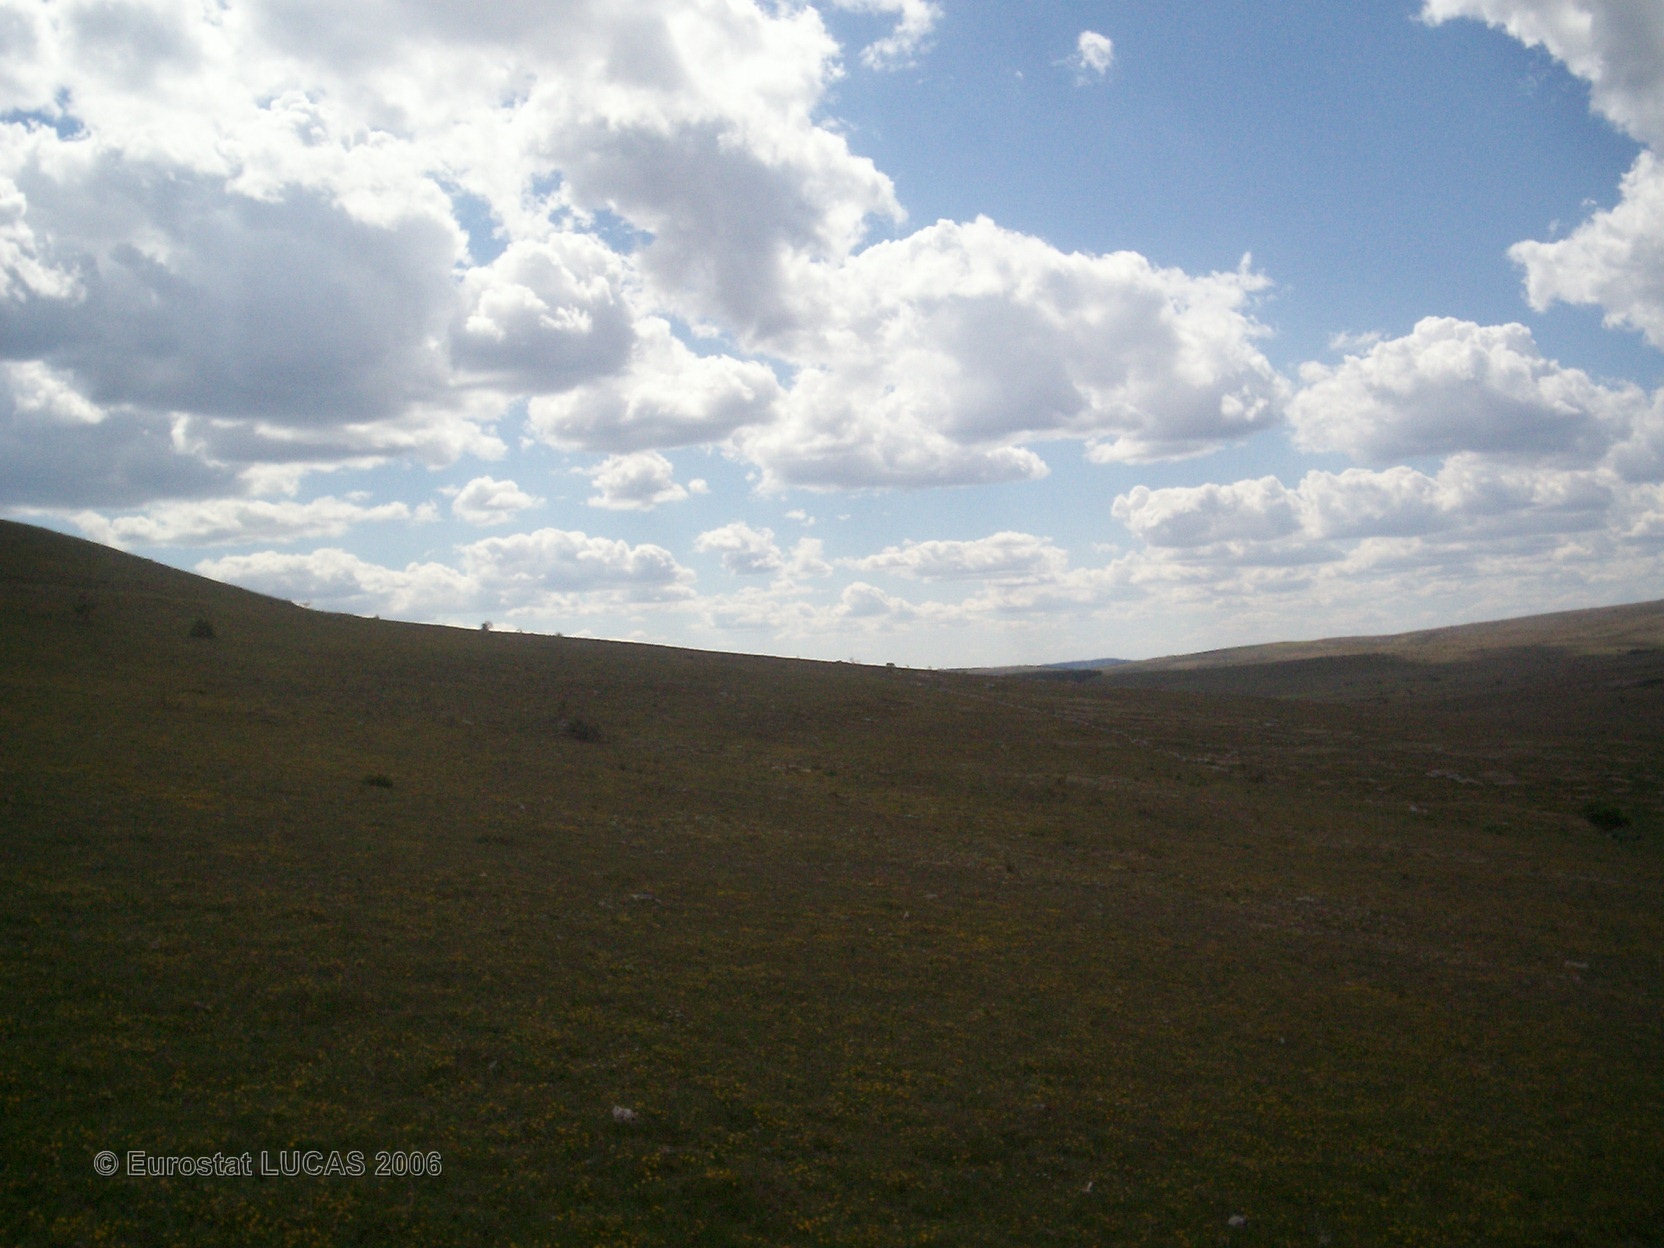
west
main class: Grassland
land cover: Grassland without tree/shrub cover
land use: Agriculture (excluding fallow land and kitchen gardens)
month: June
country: FR
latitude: 44.2329
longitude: 3.4331
